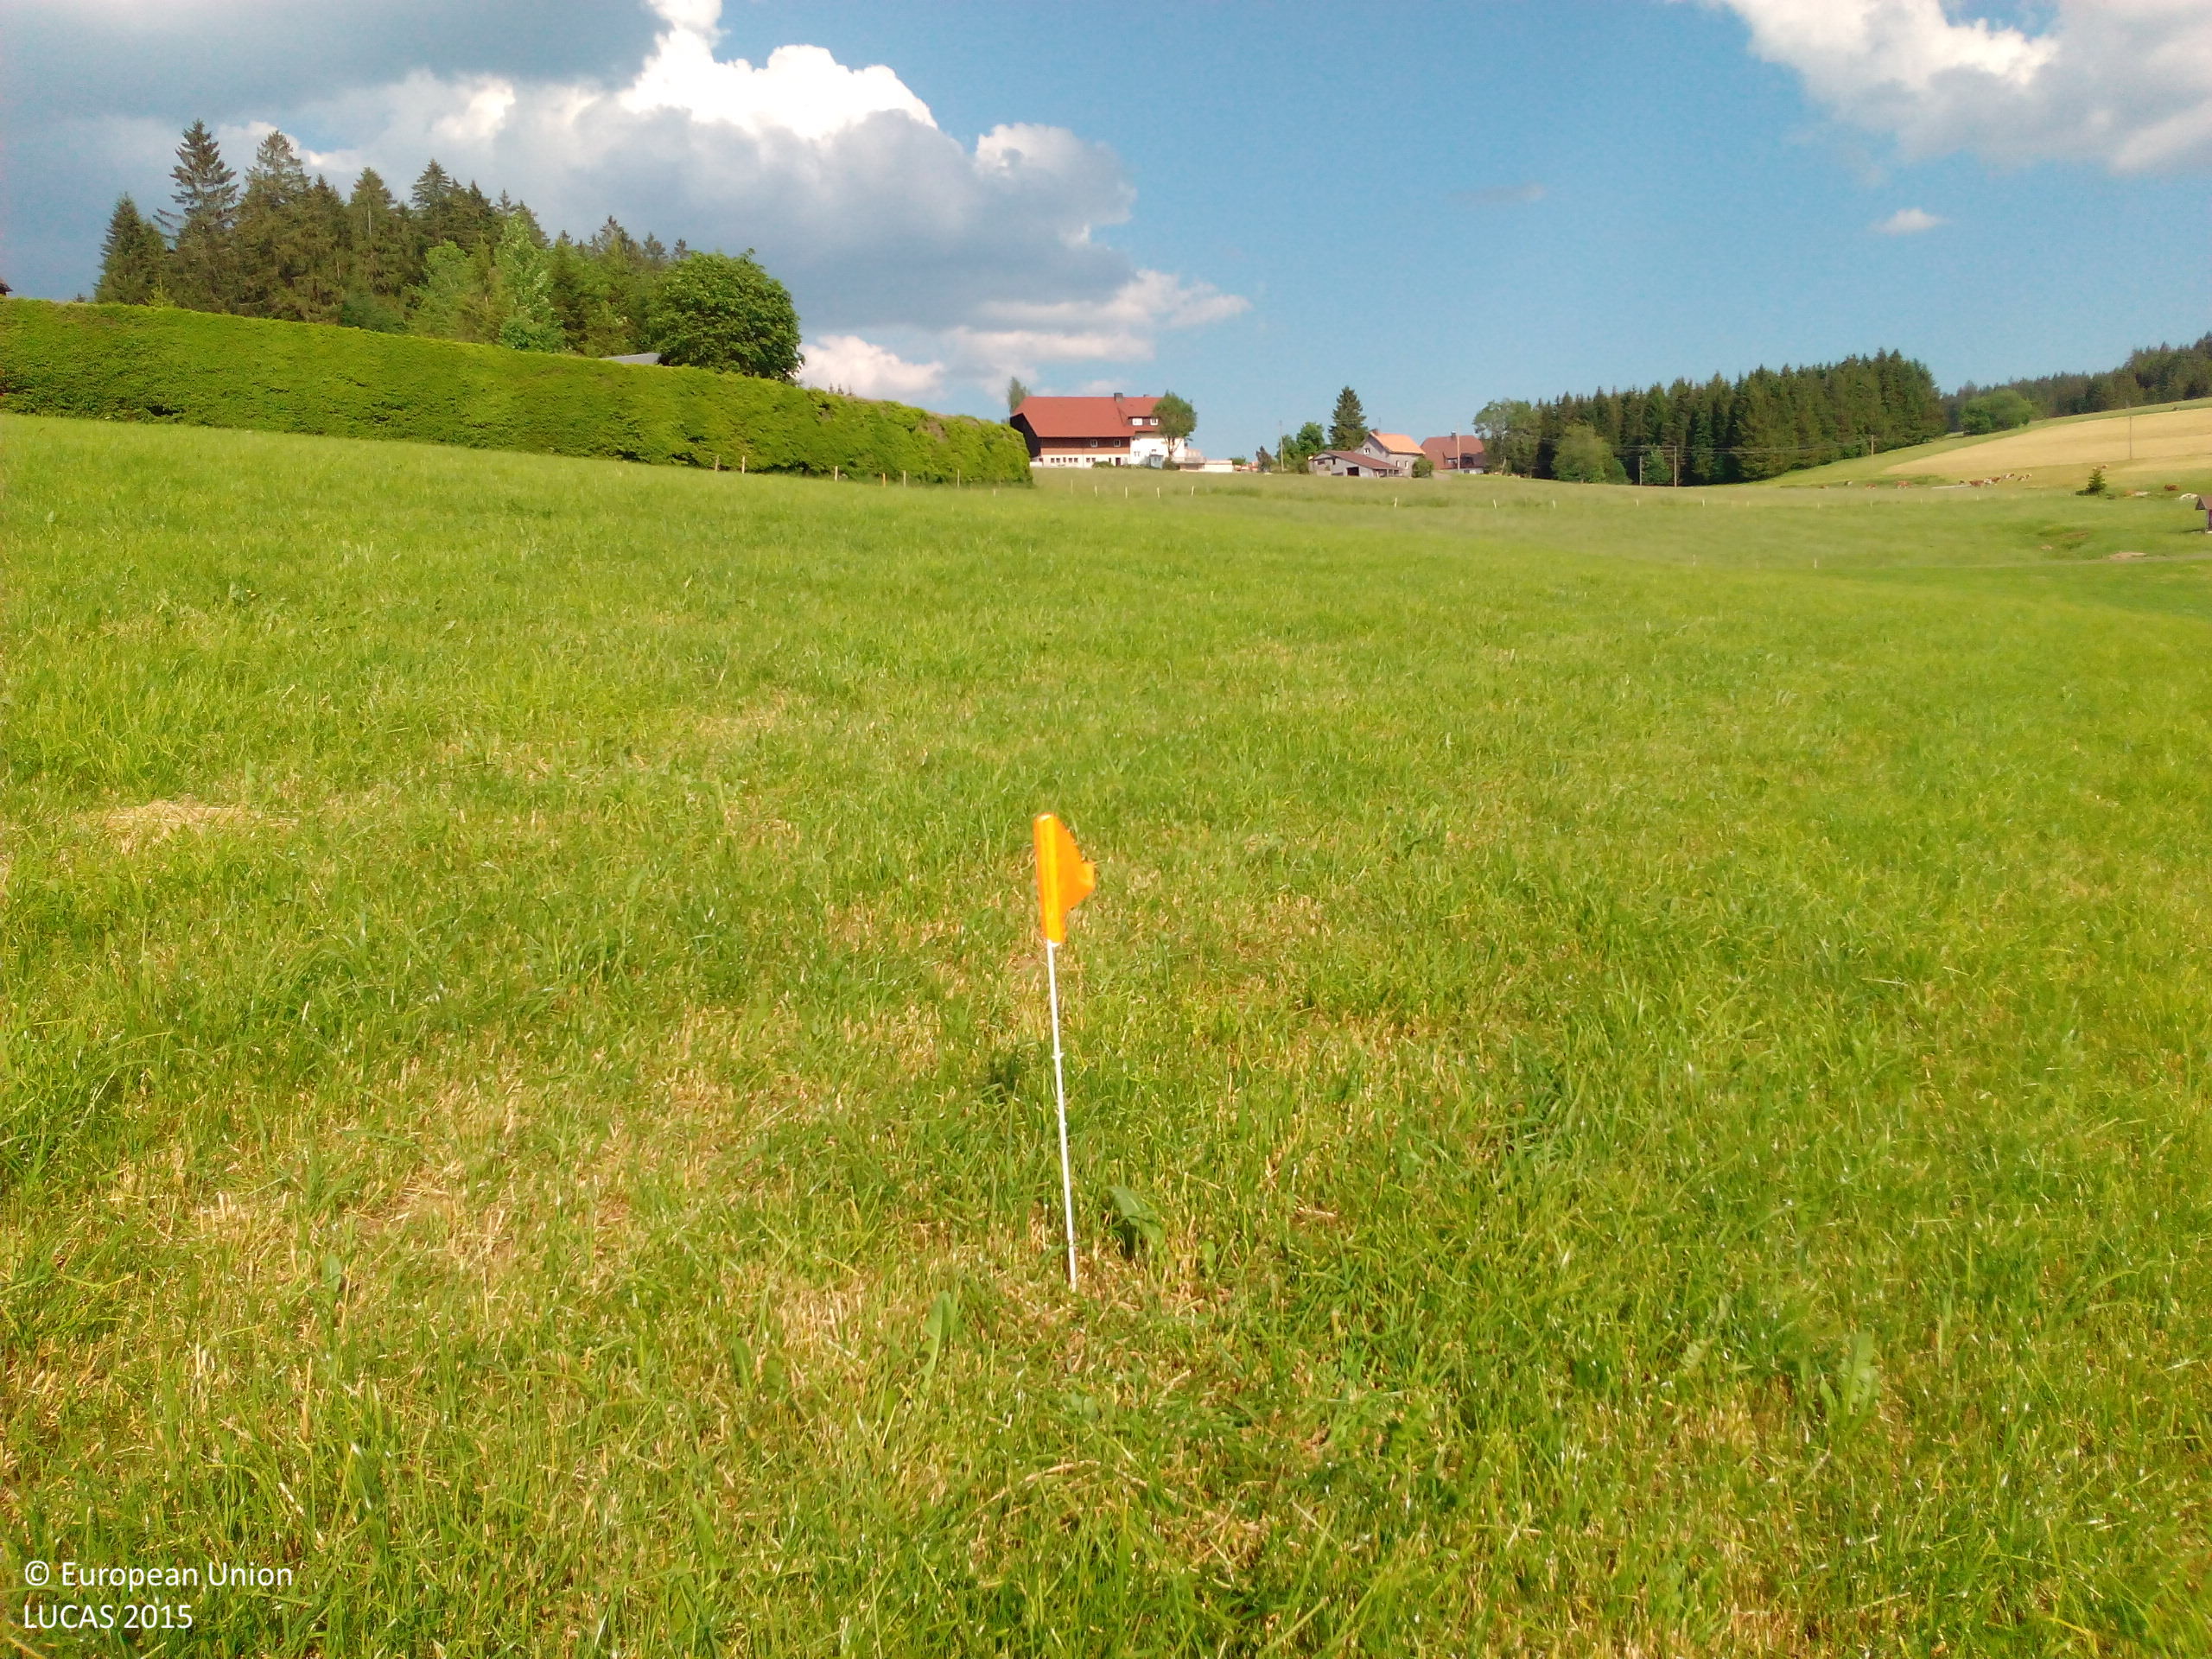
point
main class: Grassland
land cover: Grassland without tree/shrub cover
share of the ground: > 75 %
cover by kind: herbaceous plants 100 %
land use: Agriculture (excluding fallow land and kitchen gardens)
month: June
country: DE
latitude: 47.9734
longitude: 8.1123
